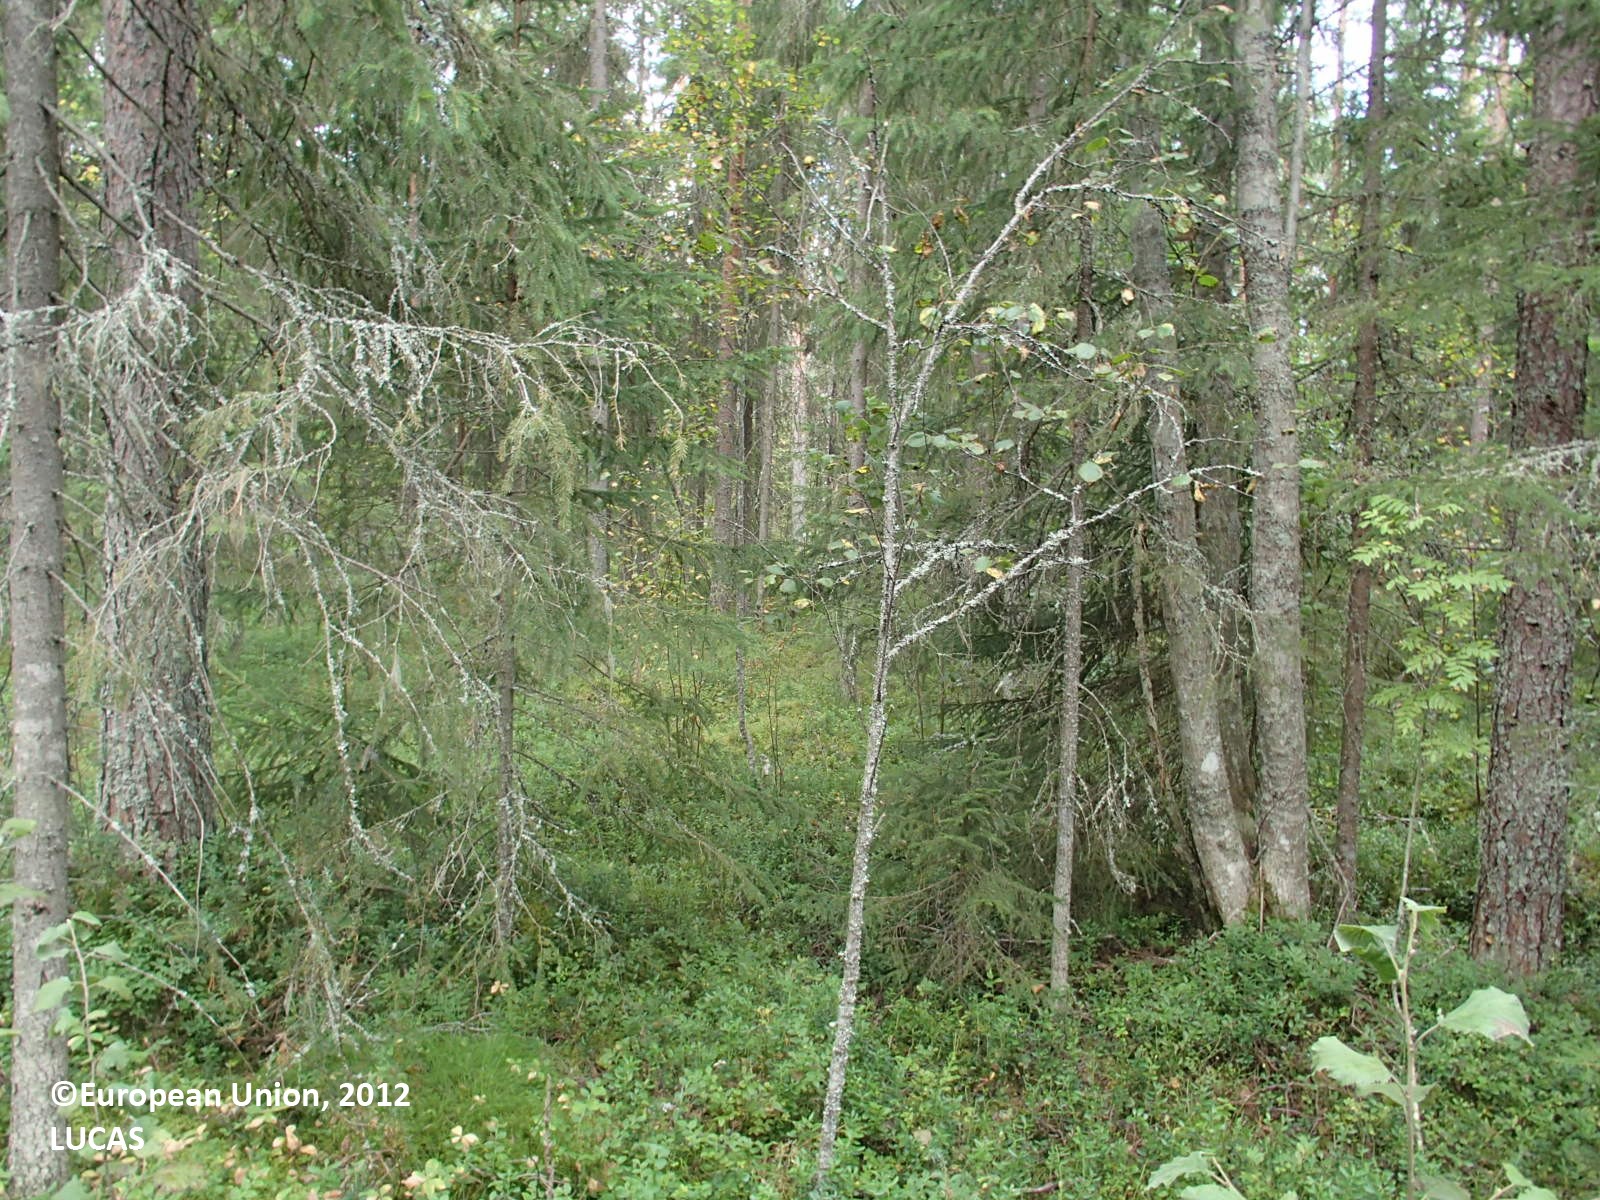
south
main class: Woodland
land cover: Other mixed woodland
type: boreal forest
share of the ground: > 75 %
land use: Forestry
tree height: > 5 m
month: August
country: FI
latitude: 63.9668
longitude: 25.6403
